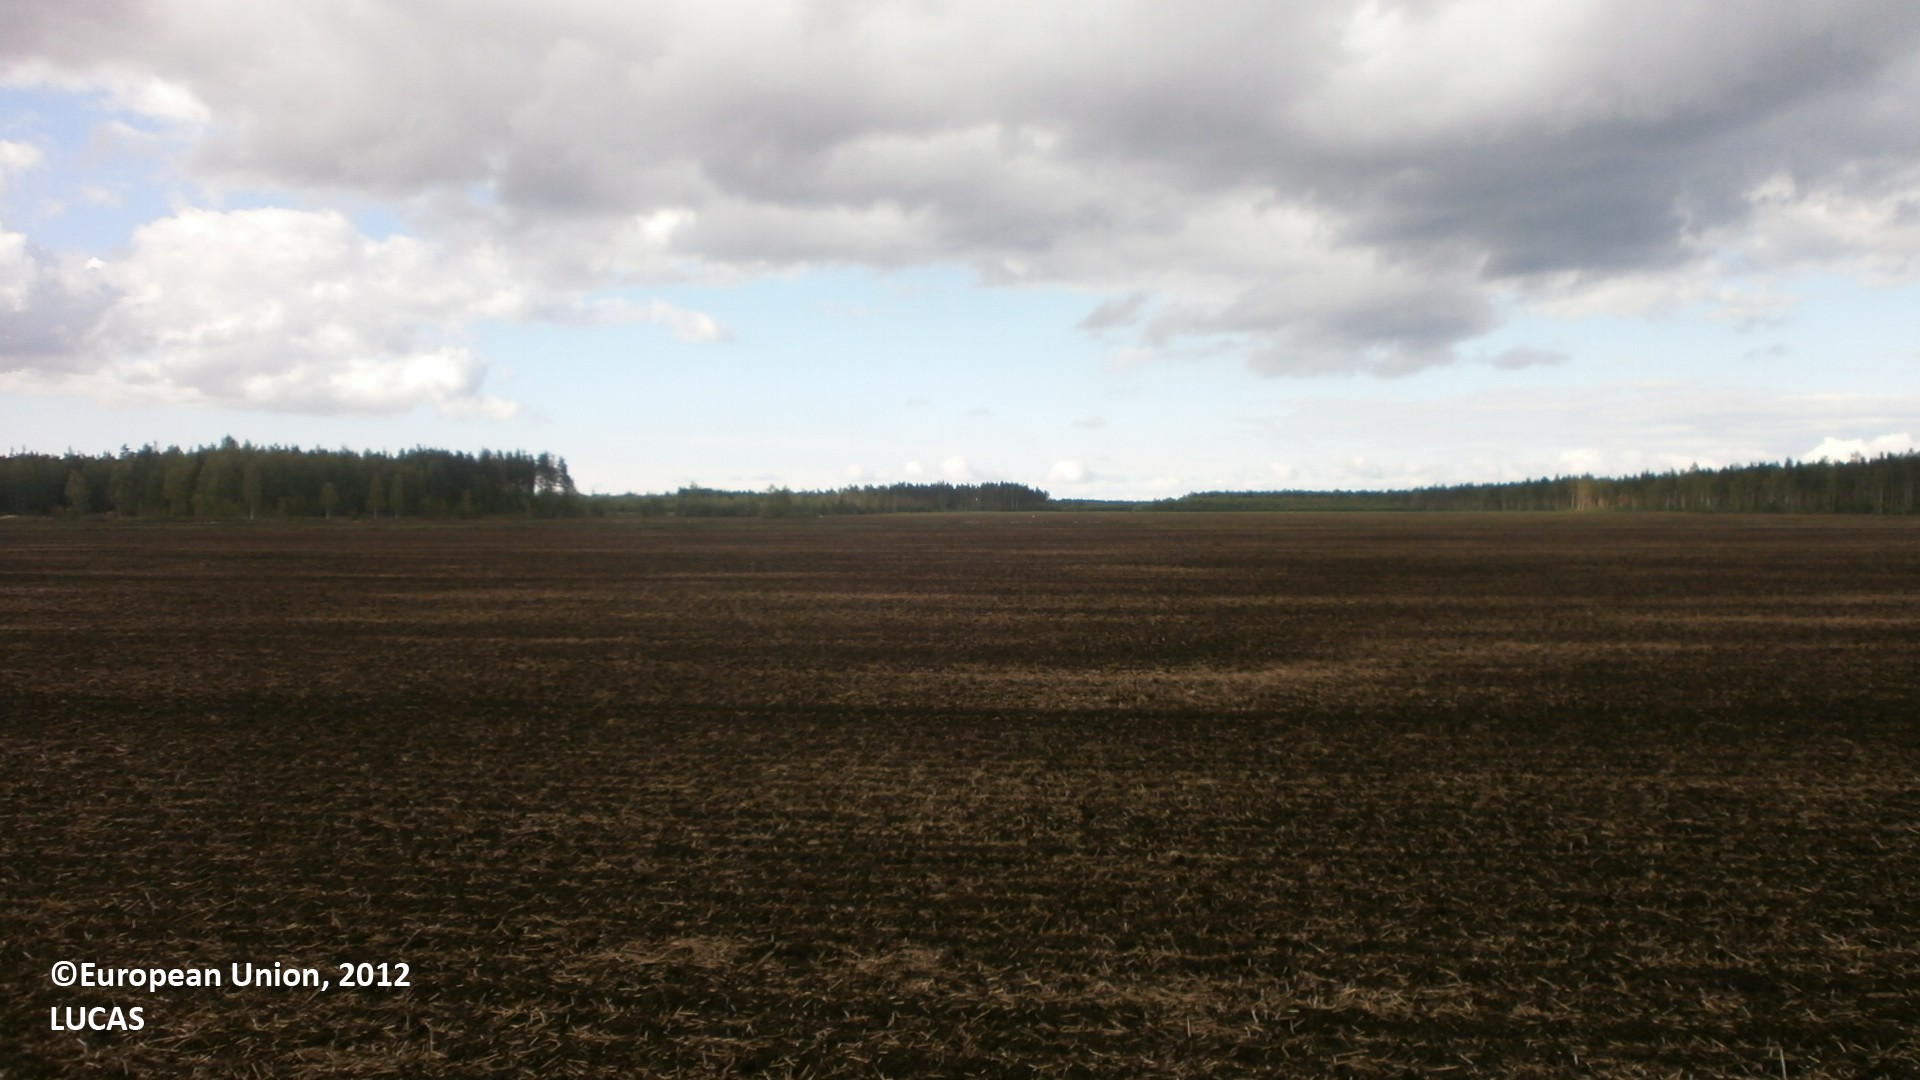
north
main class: Cropland
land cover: Barley
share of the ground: < 10 %
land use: Agriculture (excluding fallow land and kitchen gardens)
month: June
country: FI
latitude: 64.6808
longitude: 25.1481
